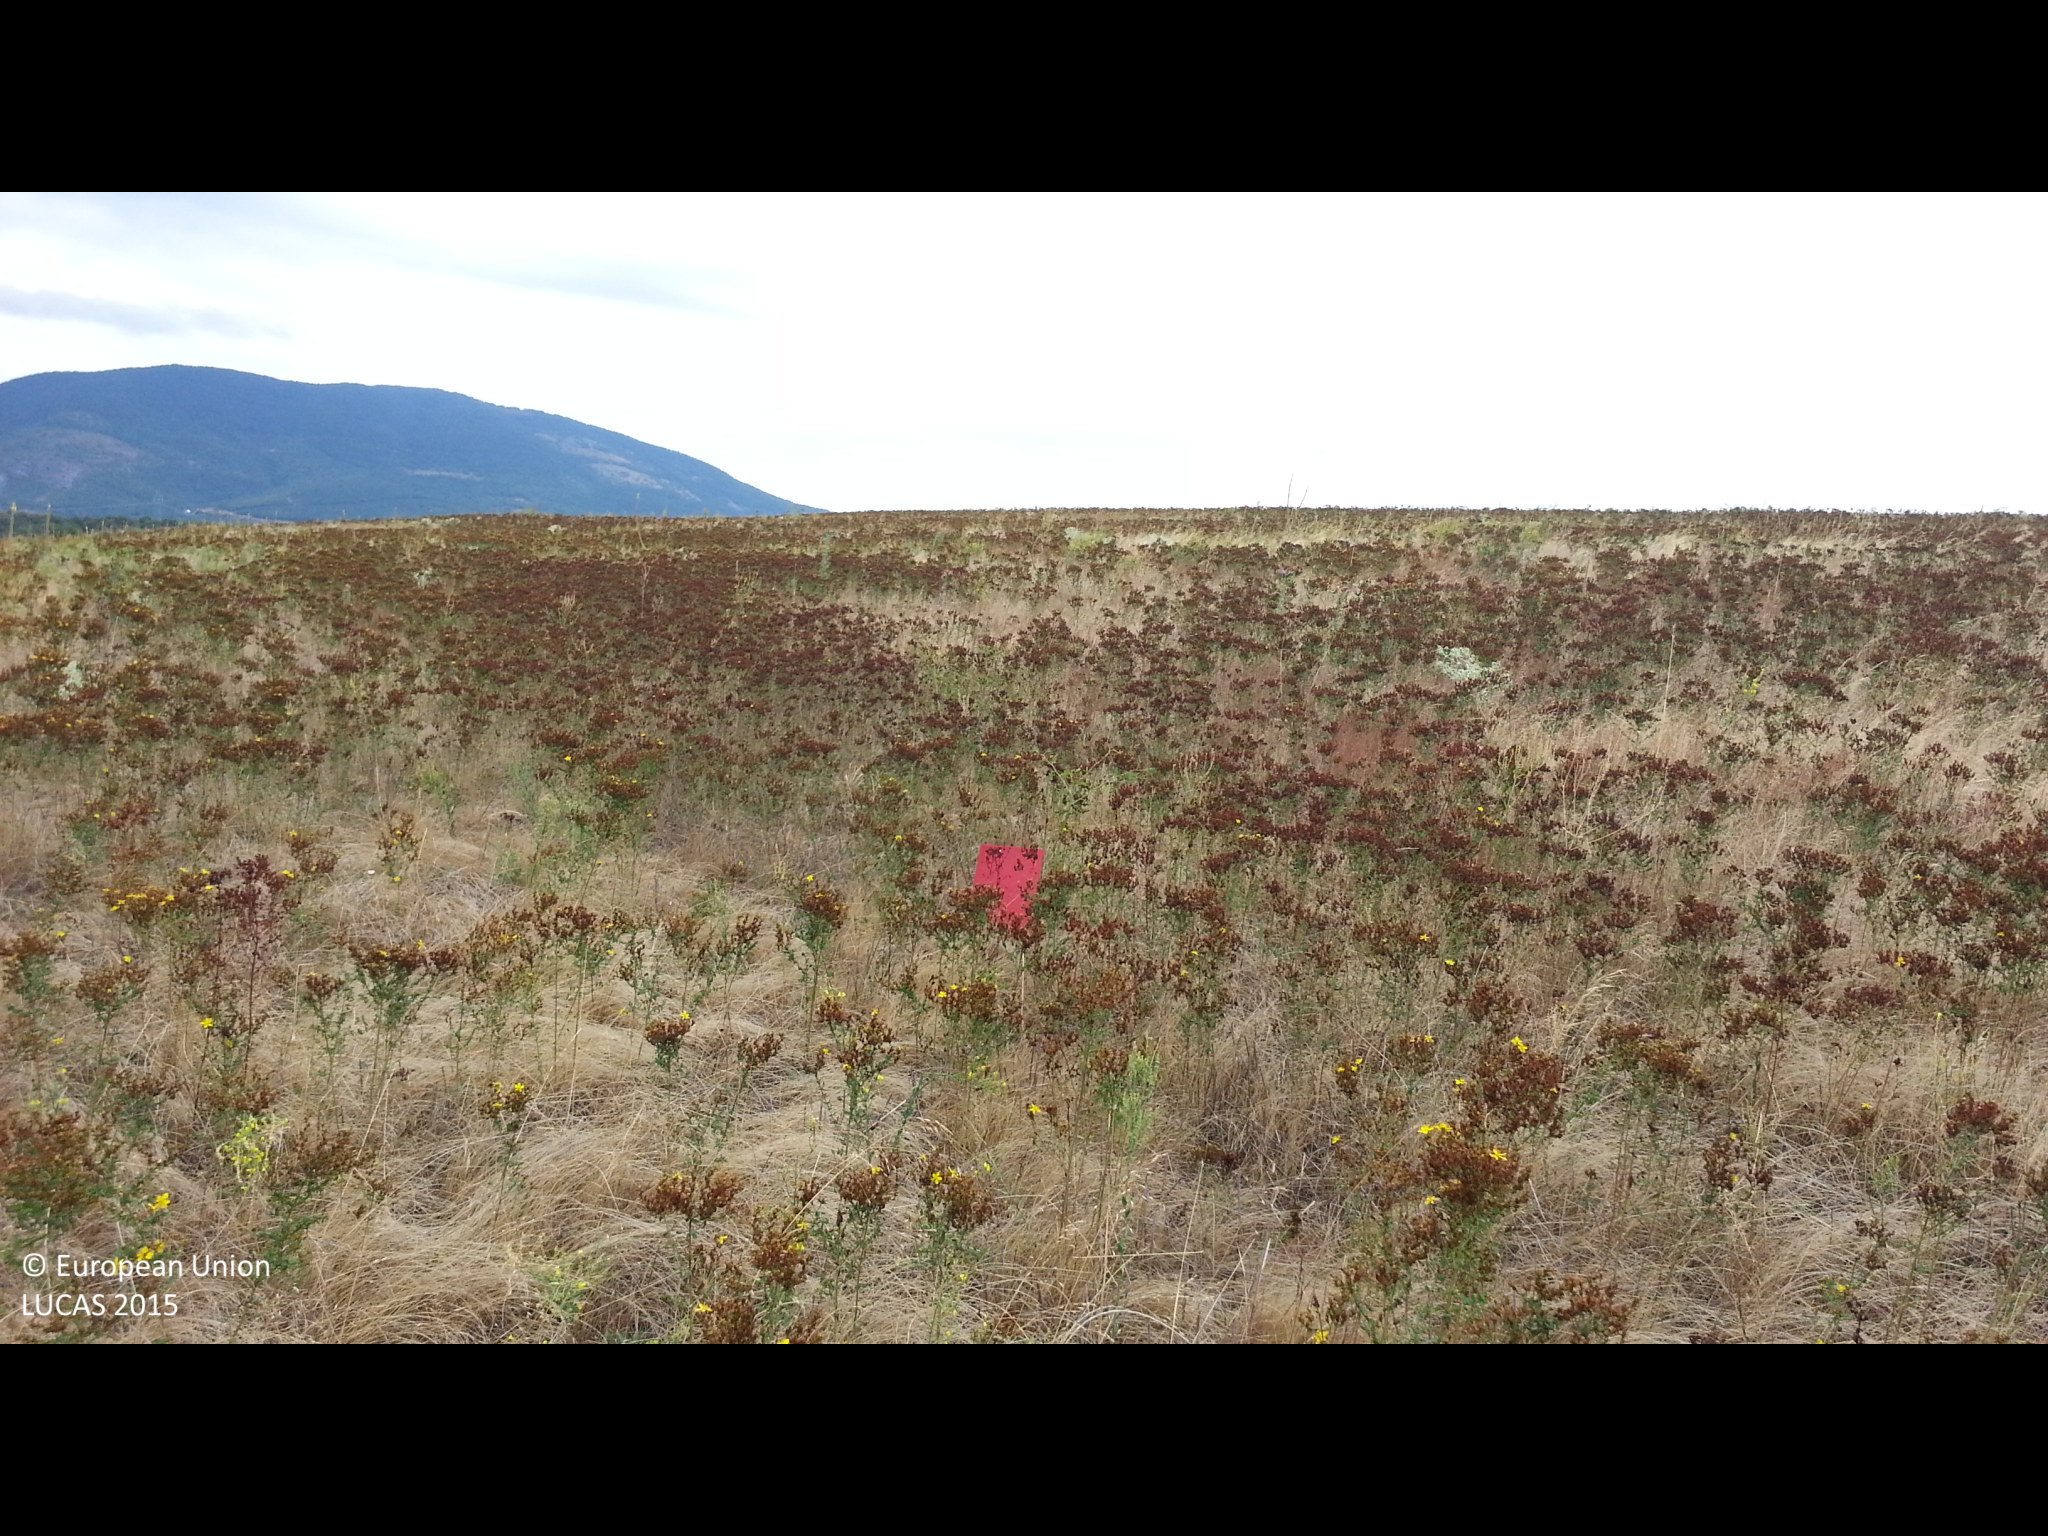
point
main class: Grassland
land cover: Spontaneously vegetated surfaces
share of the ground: > 75 %
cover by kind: herbaceous plants 100 %
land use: Fallow land
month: August
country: BG
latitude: 42.3009
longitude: 22.8945
